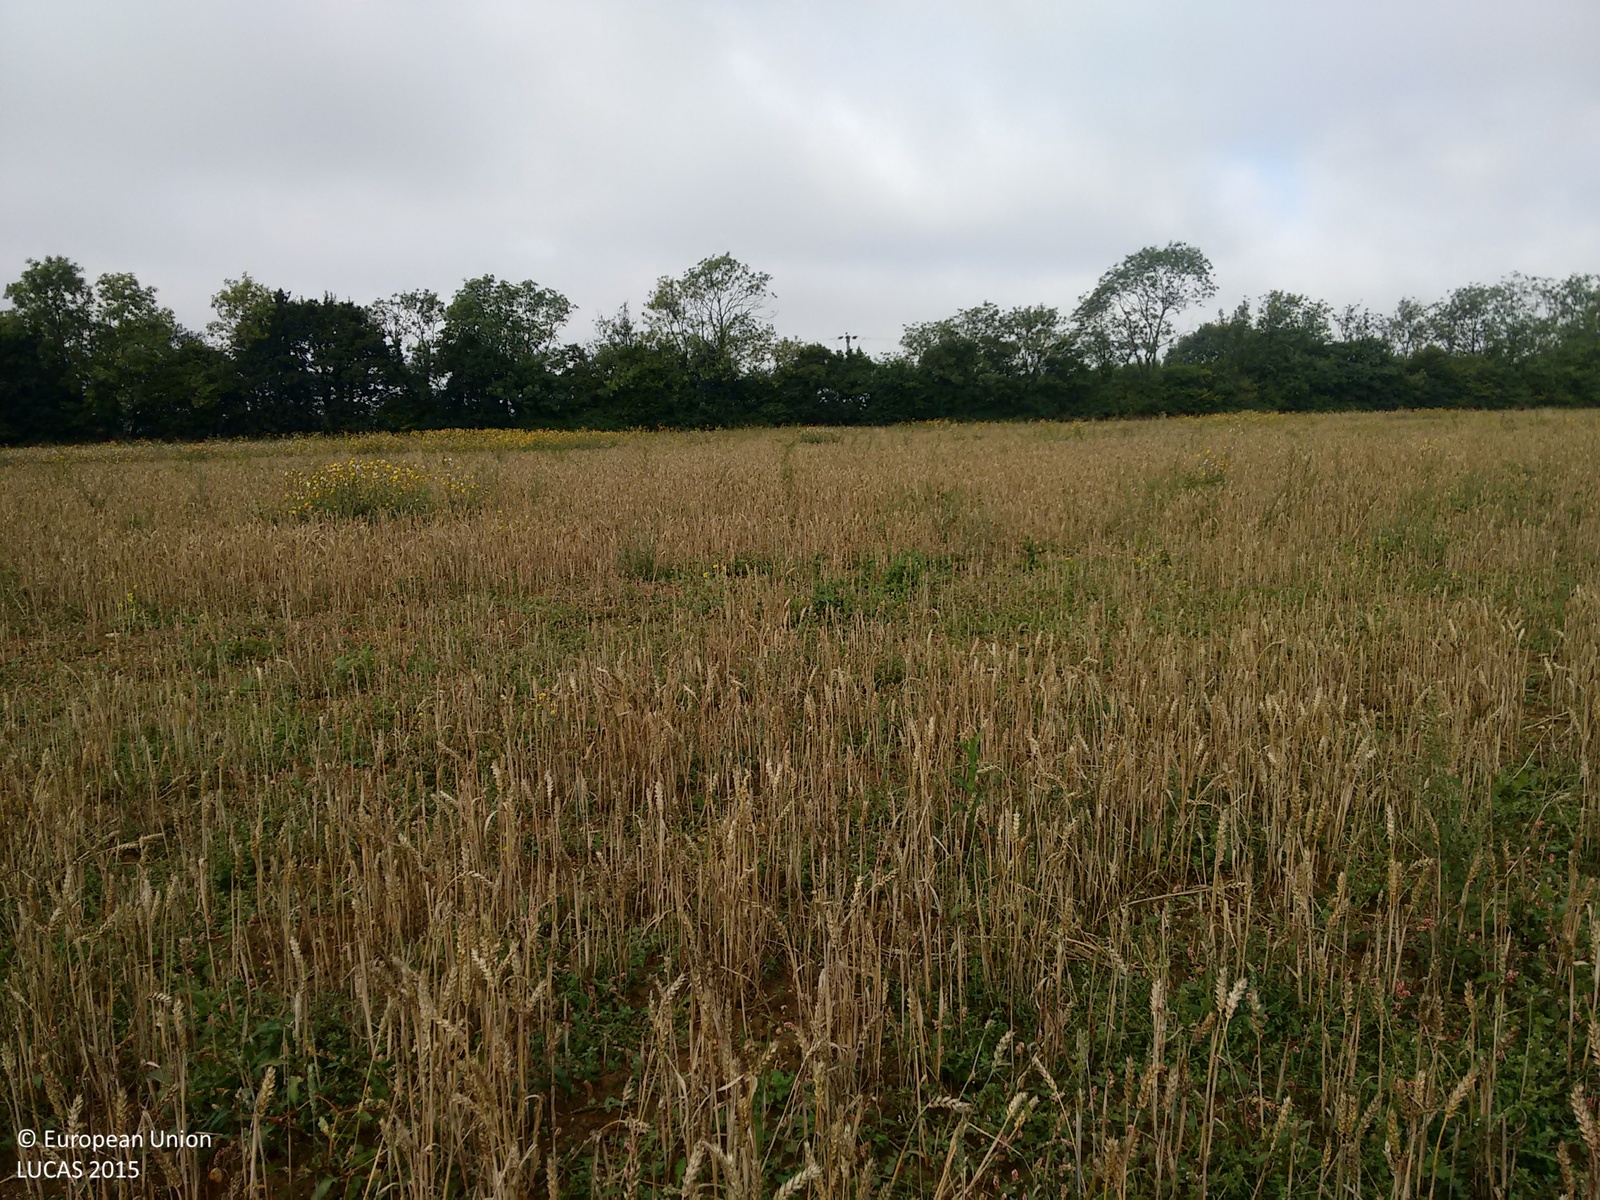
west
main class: Cropland
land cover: Common wheat
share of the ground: > 75 %
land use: Agriculture (excluding fallow land and kitchen gardens)
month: September
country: GB
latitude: 52.2001
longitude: 0.5650
